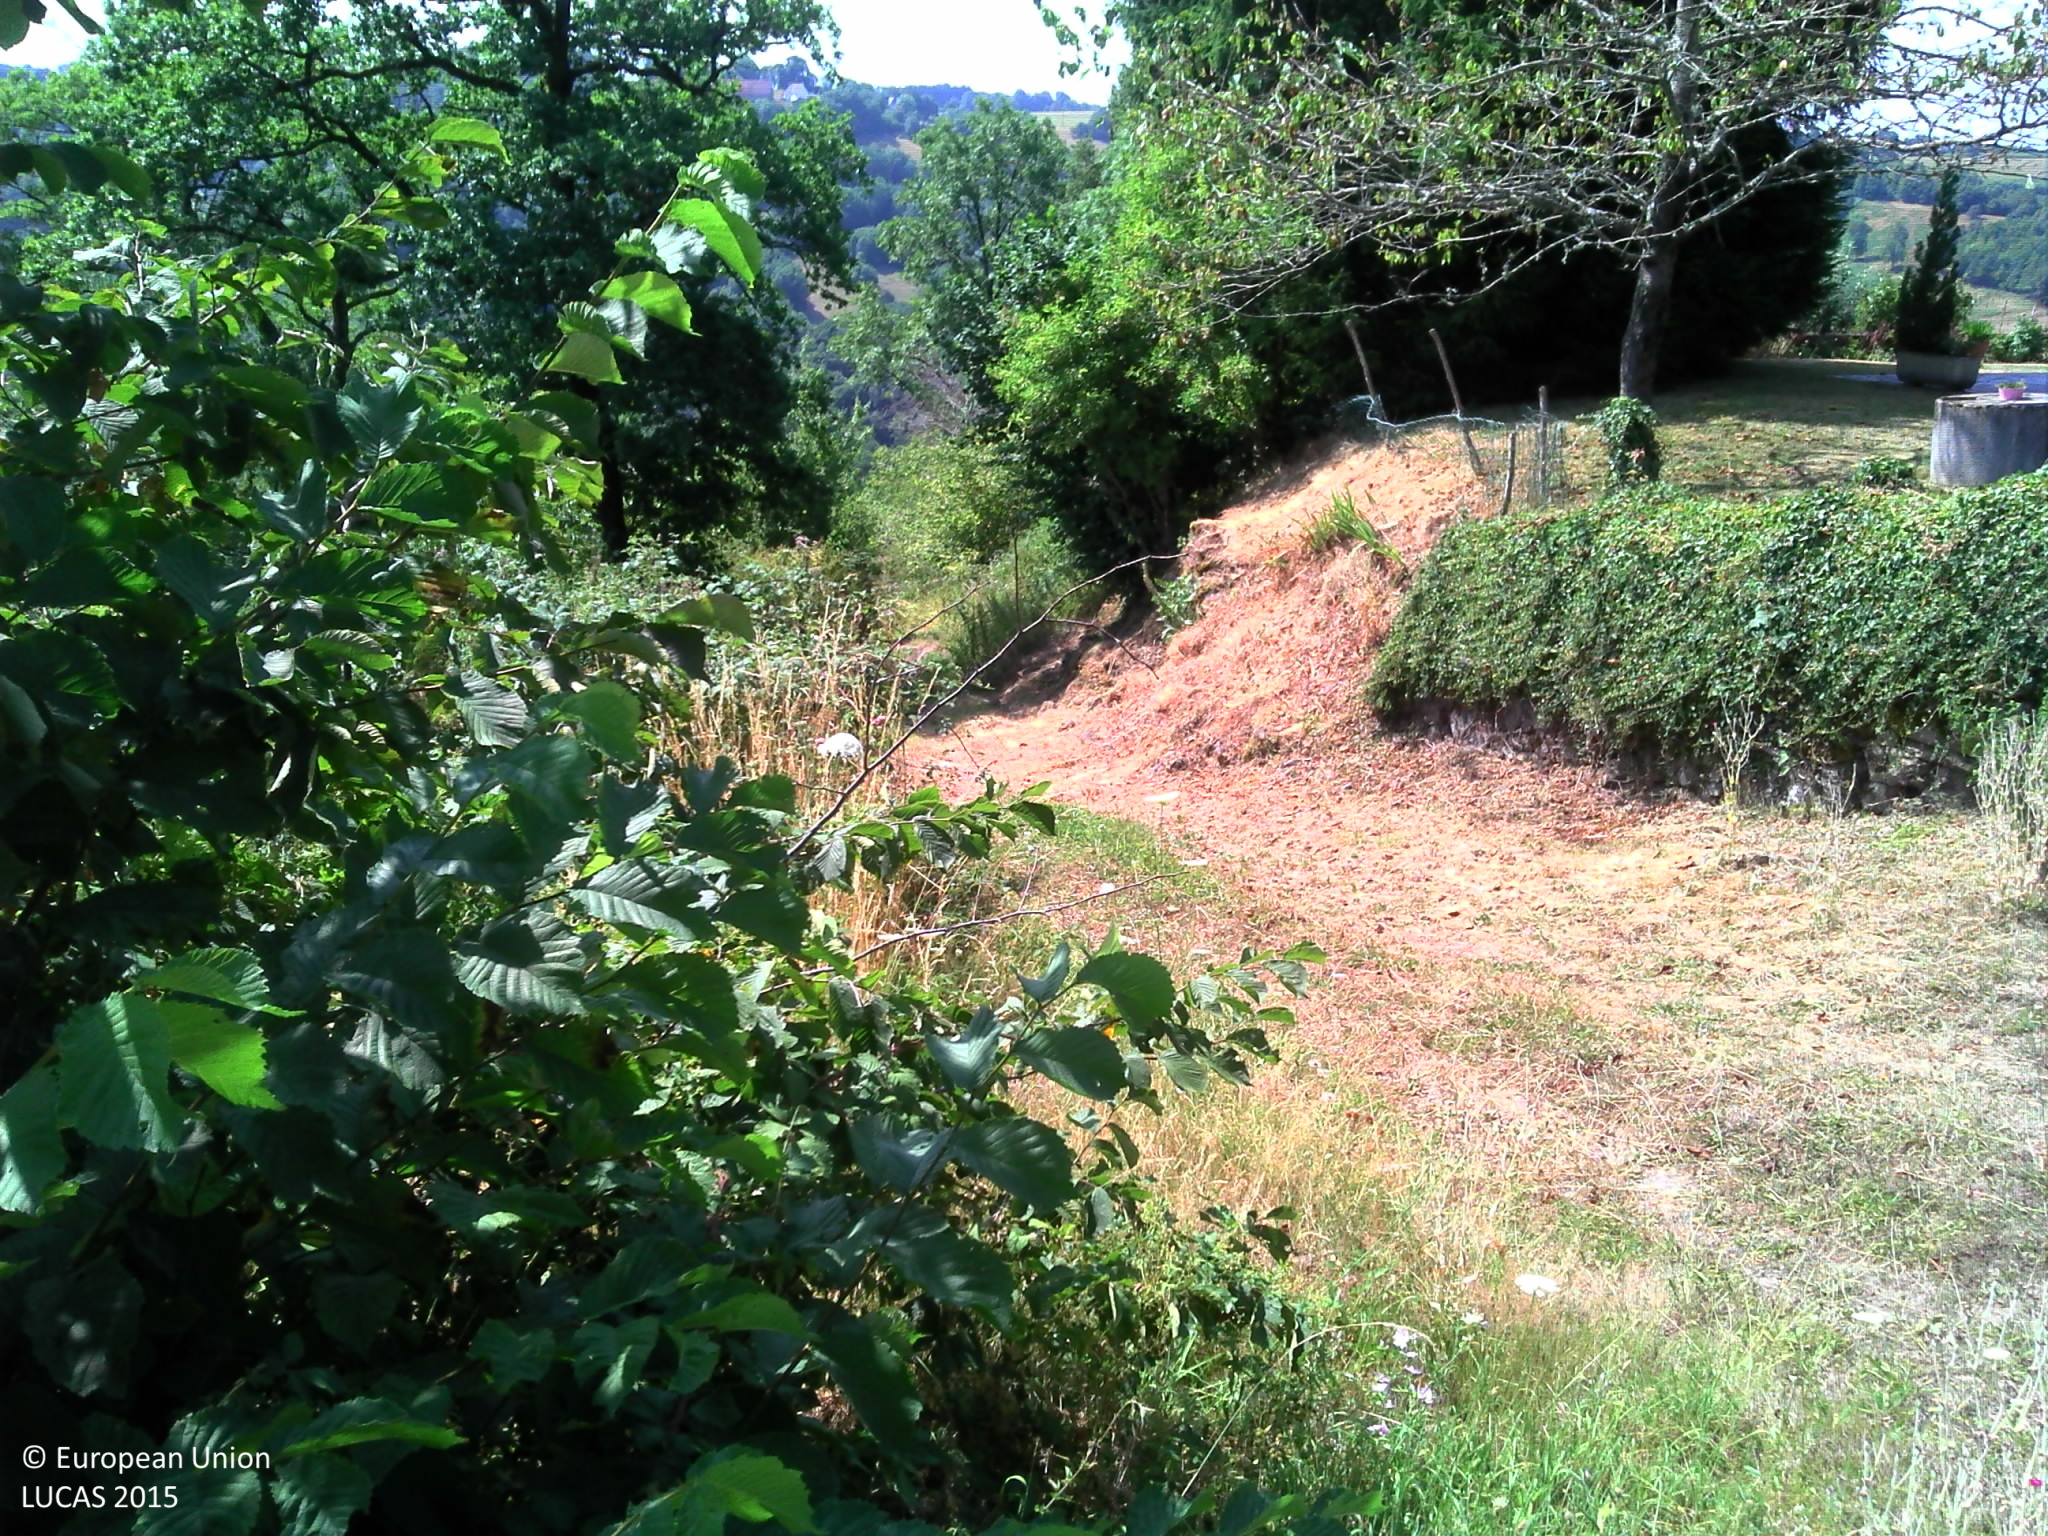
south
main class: Grassland
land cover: Grassland without tree/shrub cover
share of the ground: > 75 %
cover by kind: herbaceous plants 100 %
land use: Road transport
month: July
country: FR
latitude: 45.1187
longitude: 2.3594
